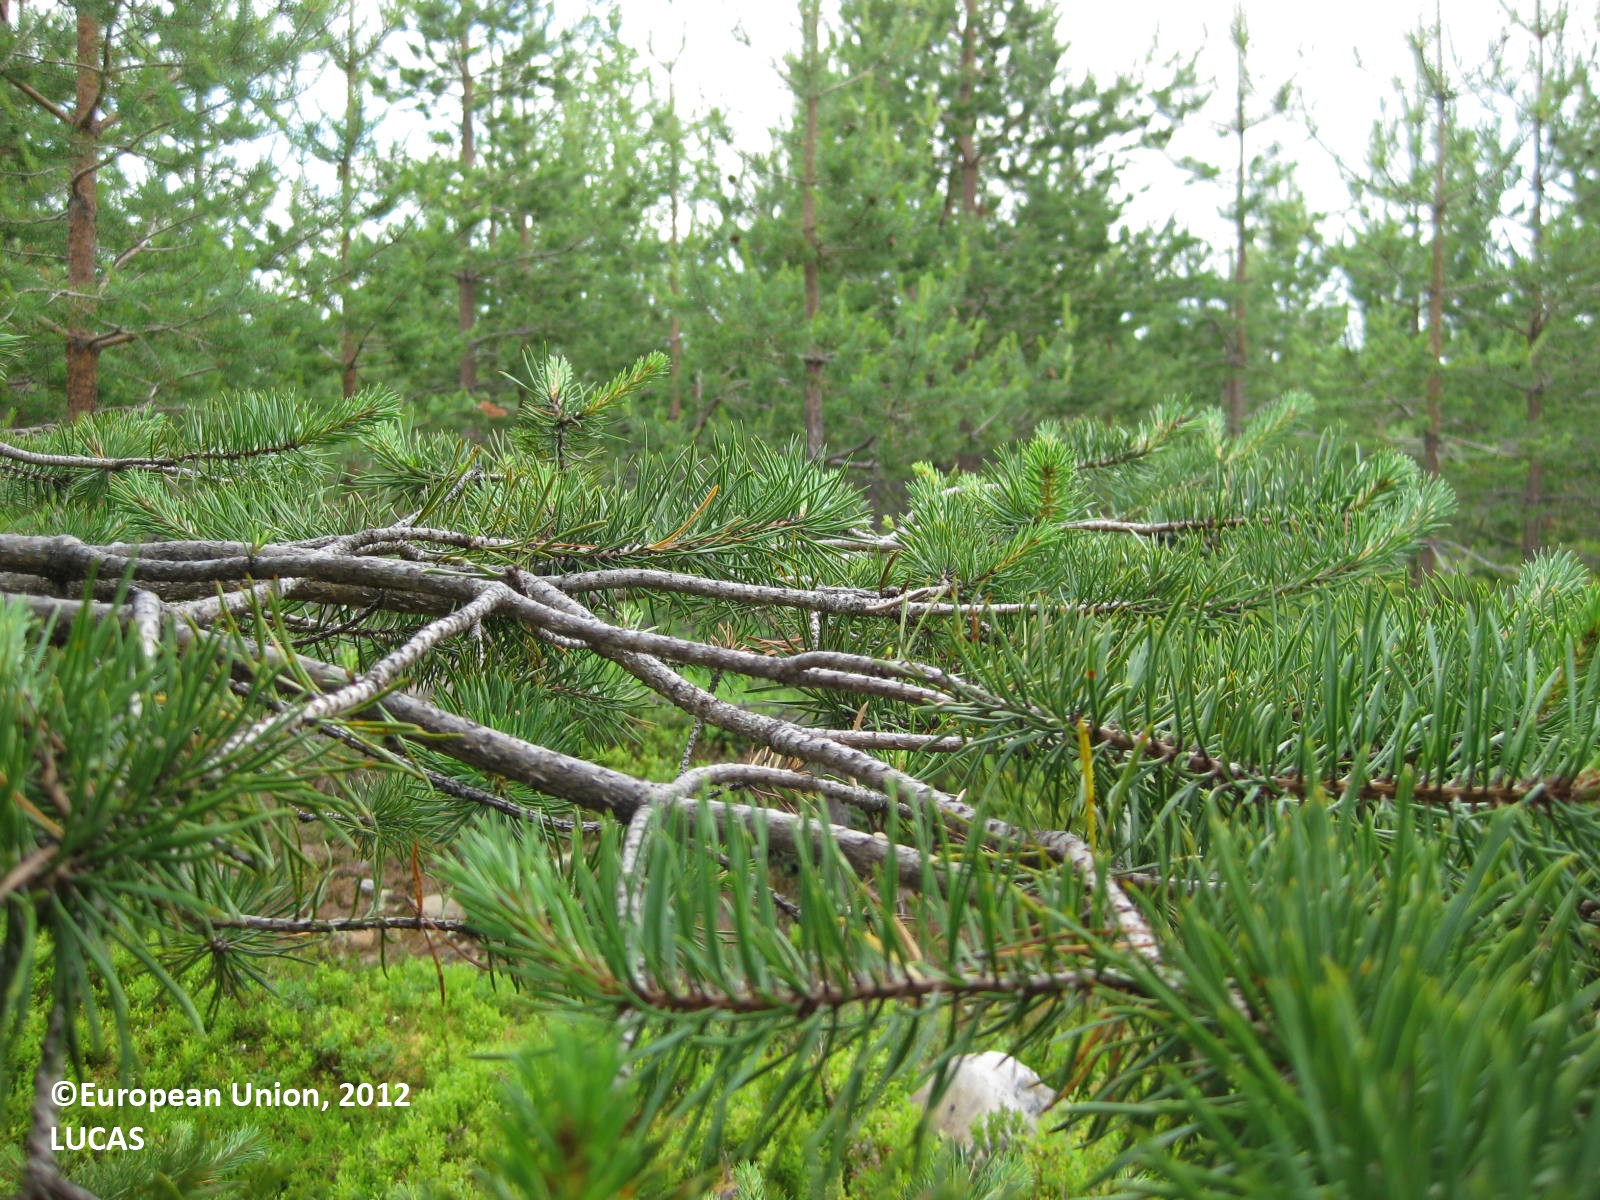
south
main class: Woodland
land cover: Pine dominated coniferous woodland
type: boreal forest
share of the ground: 50 - 75 %
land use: Forestry
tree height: > 5 m
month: July
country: FI
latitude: 65.7513
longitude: 29.5517
